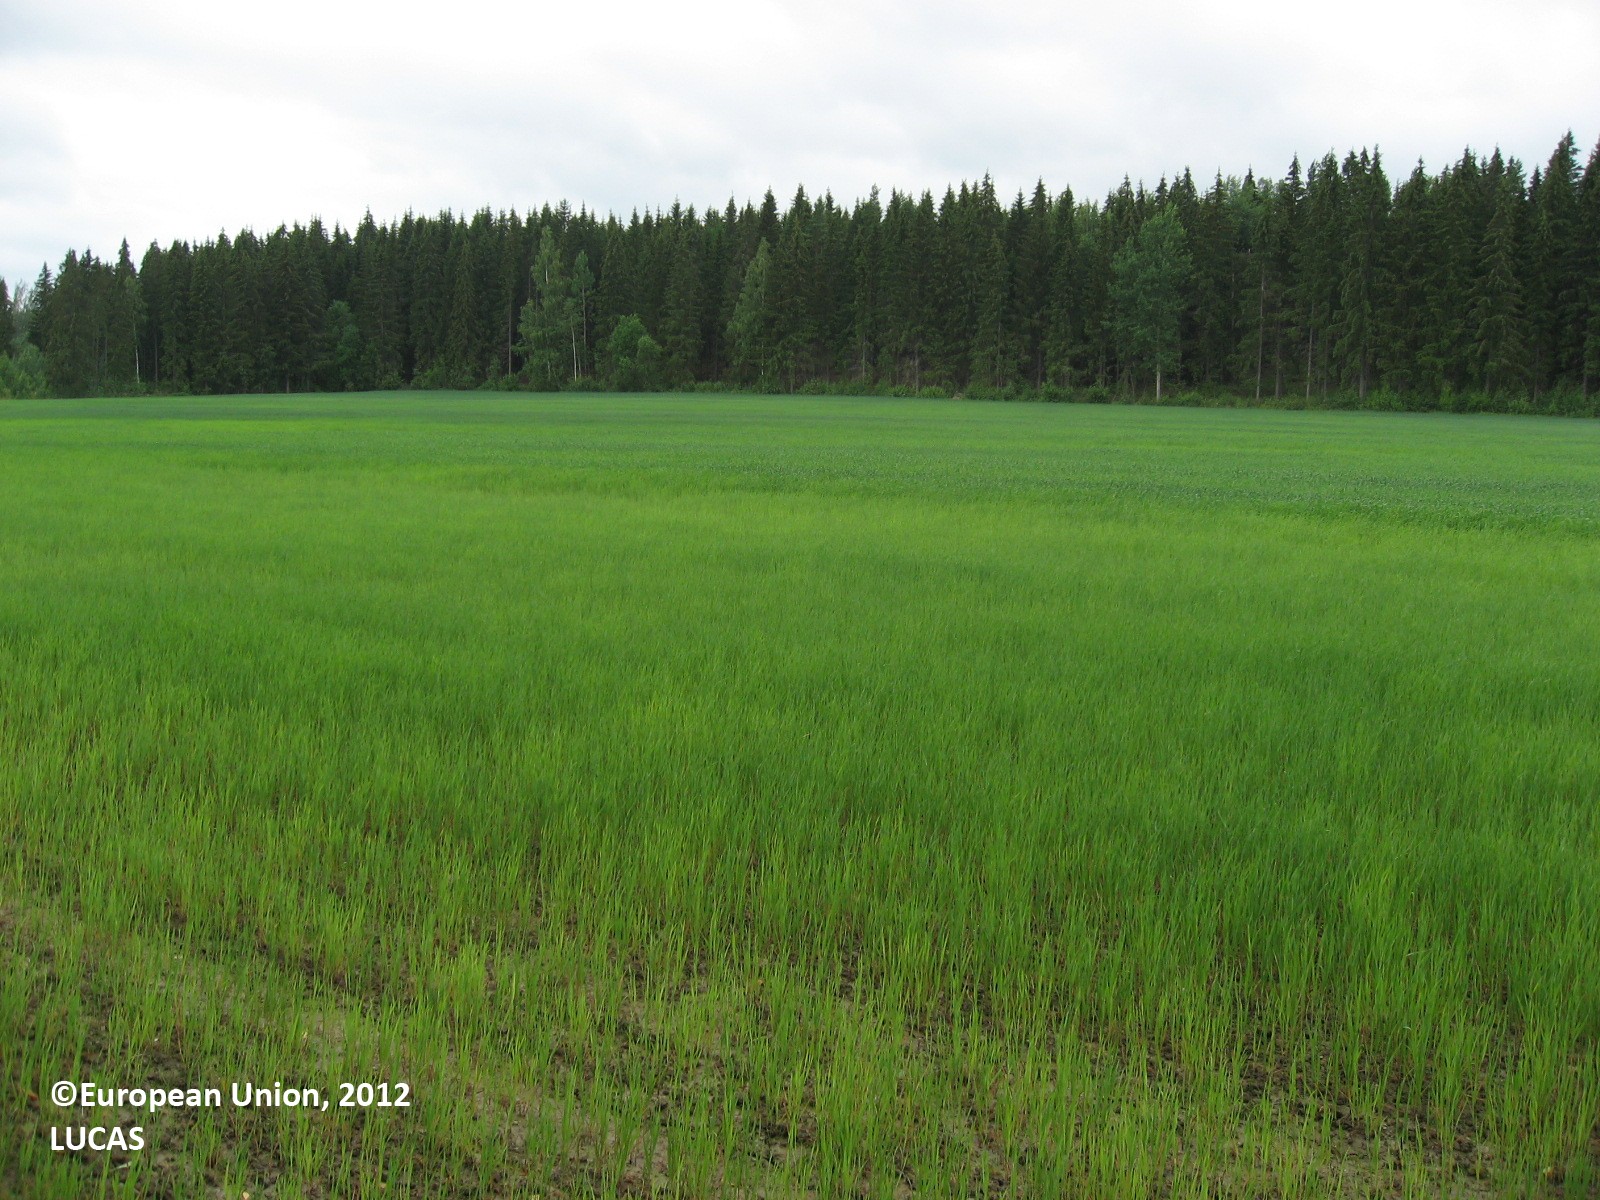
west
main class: Cropland
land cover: Oats
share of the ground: 50 - 75 %
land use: Agriculture (excluding fallow land and kitchen gardens)
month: July
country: FI
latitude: 60.8854
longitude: 25.6245
